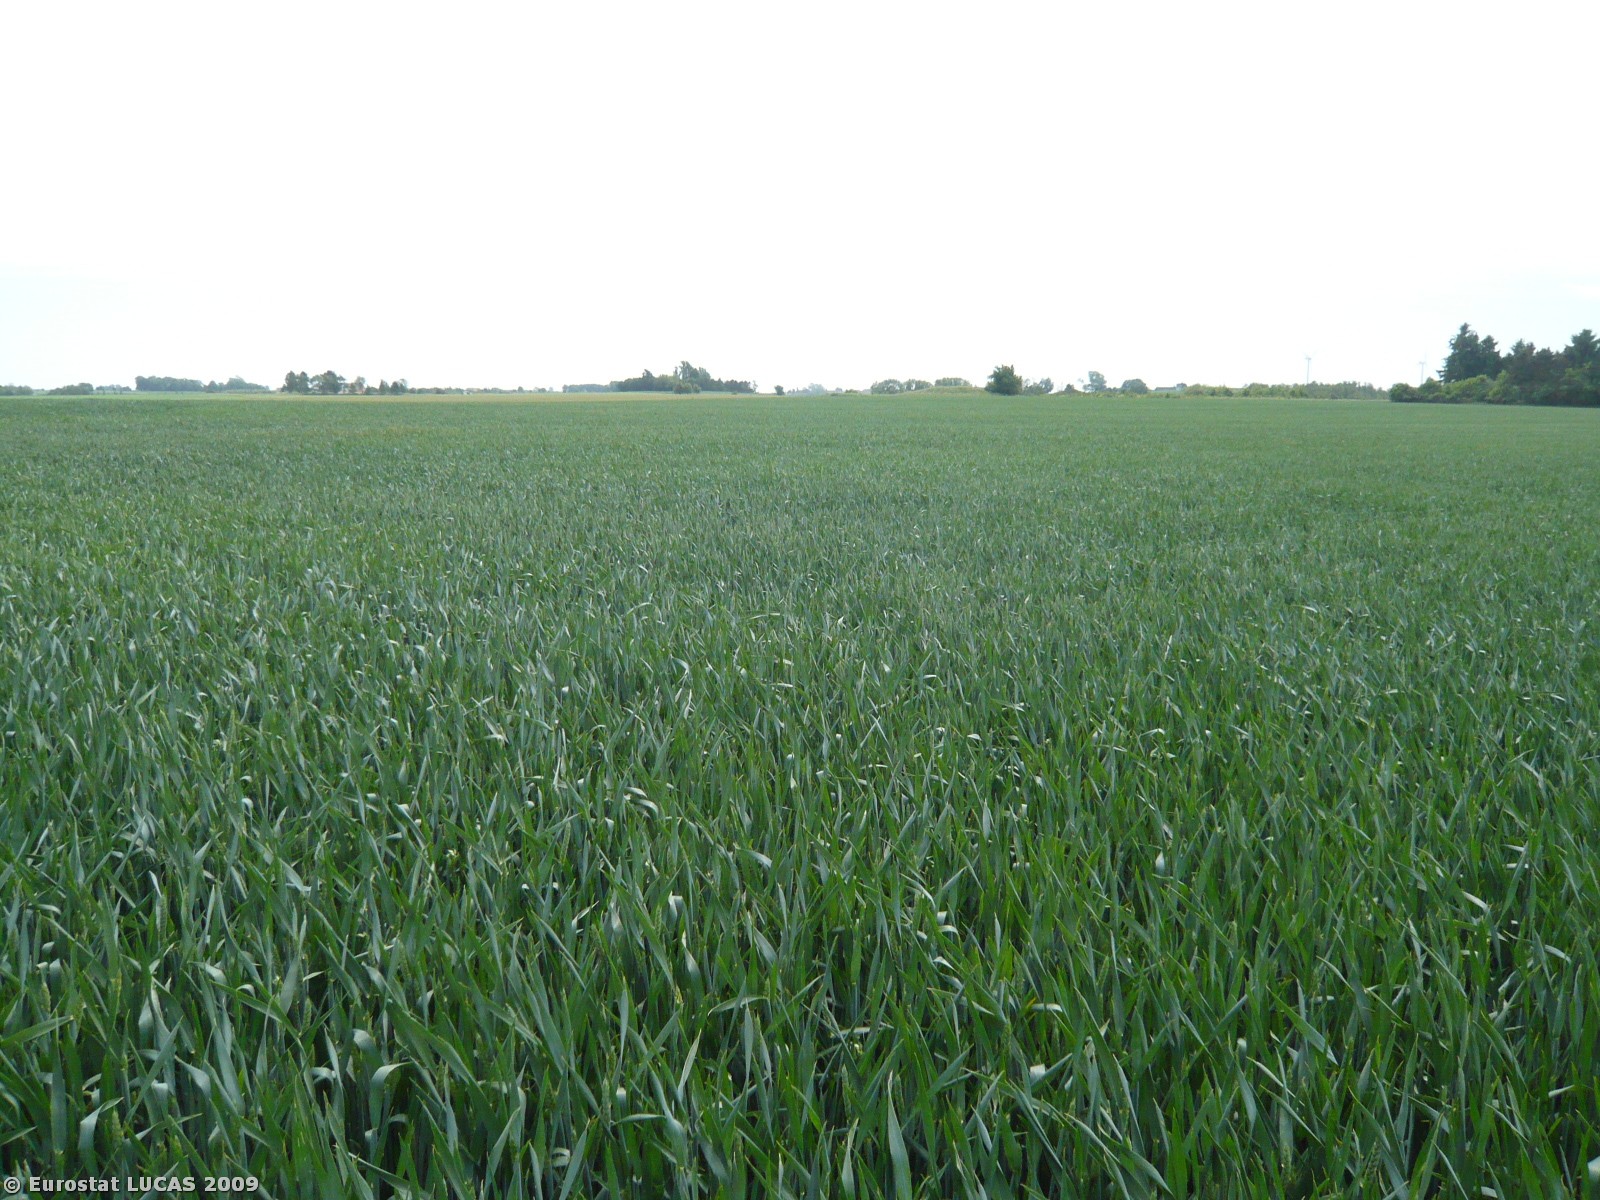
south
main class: Cropland
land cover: Common wheat
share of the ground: > 75 %
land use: Agriculture (excluding fallow land and kitchen gardens)
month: June
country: DK
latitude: 55.2816
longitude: 11.3686
